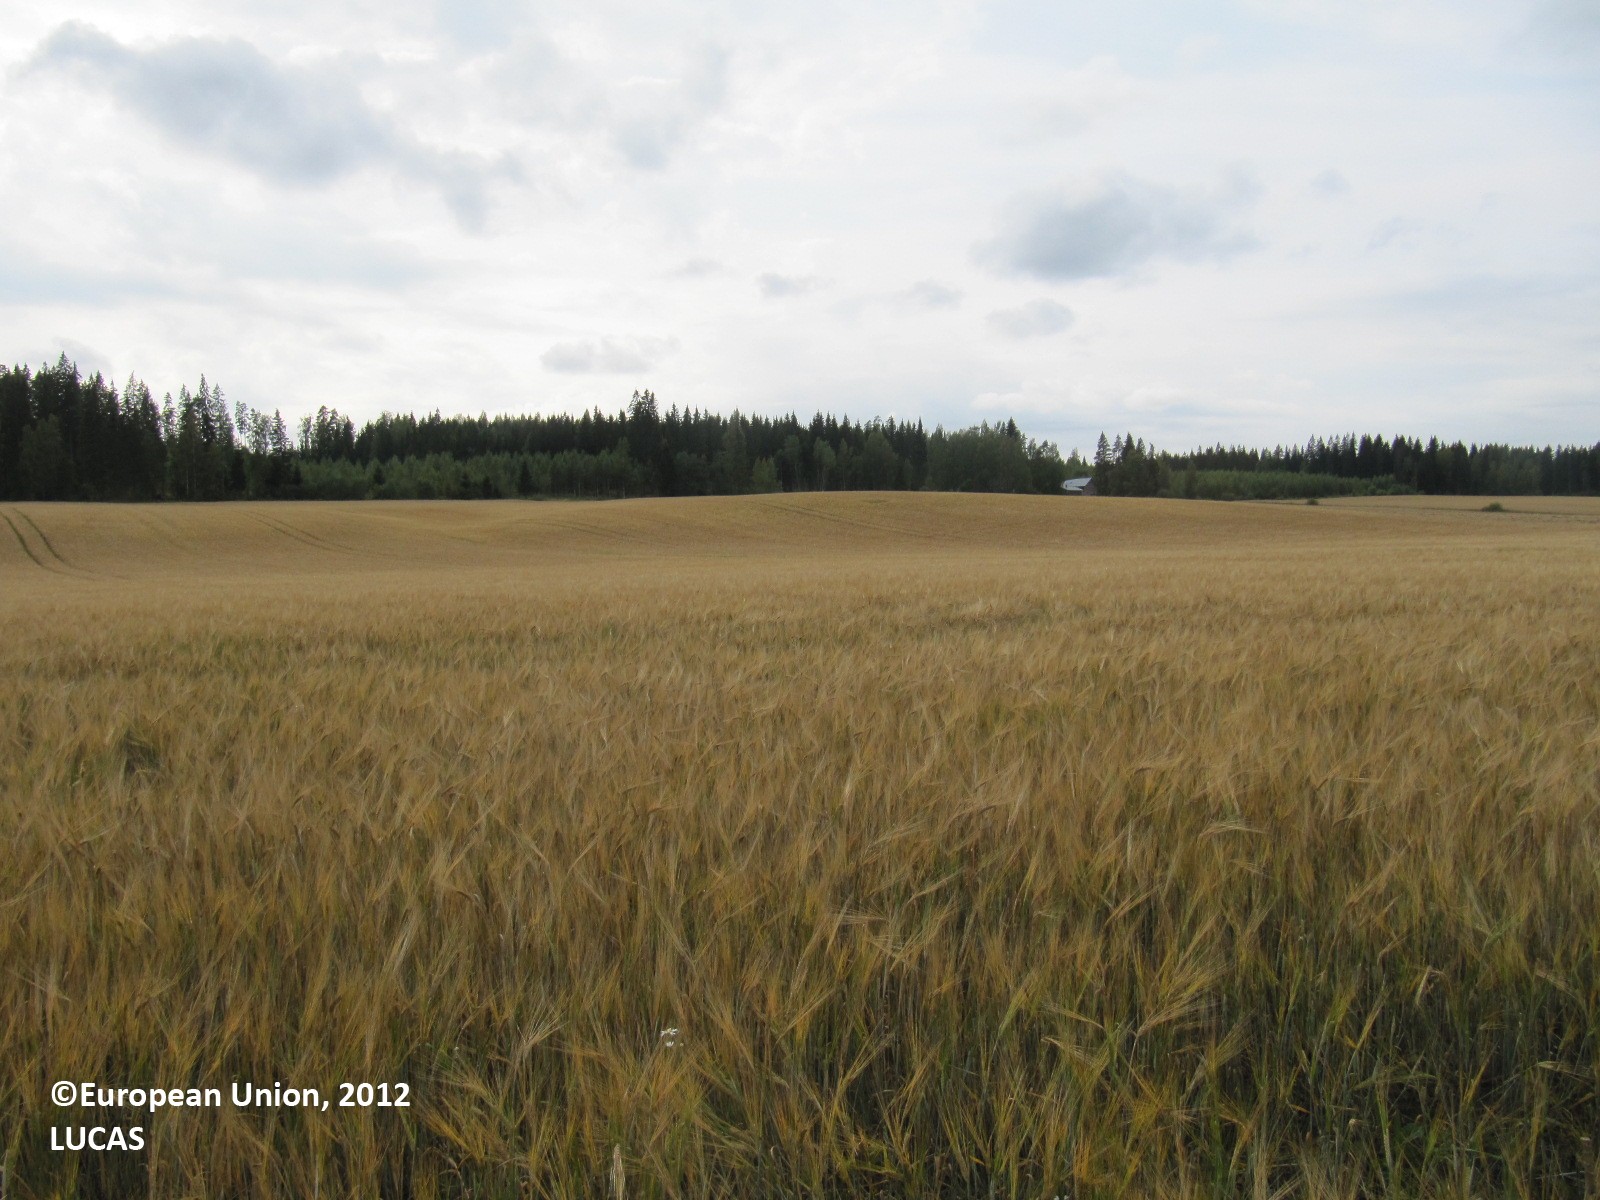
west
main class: Grassland
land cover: Grassland with sparse tree/shrub cover
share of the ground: > 75 %
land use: Agriculture (excluding fallow land and kitchen gardens)
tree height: < 5 m
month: August
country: FI
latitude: 61.1323
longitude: 22.9782
